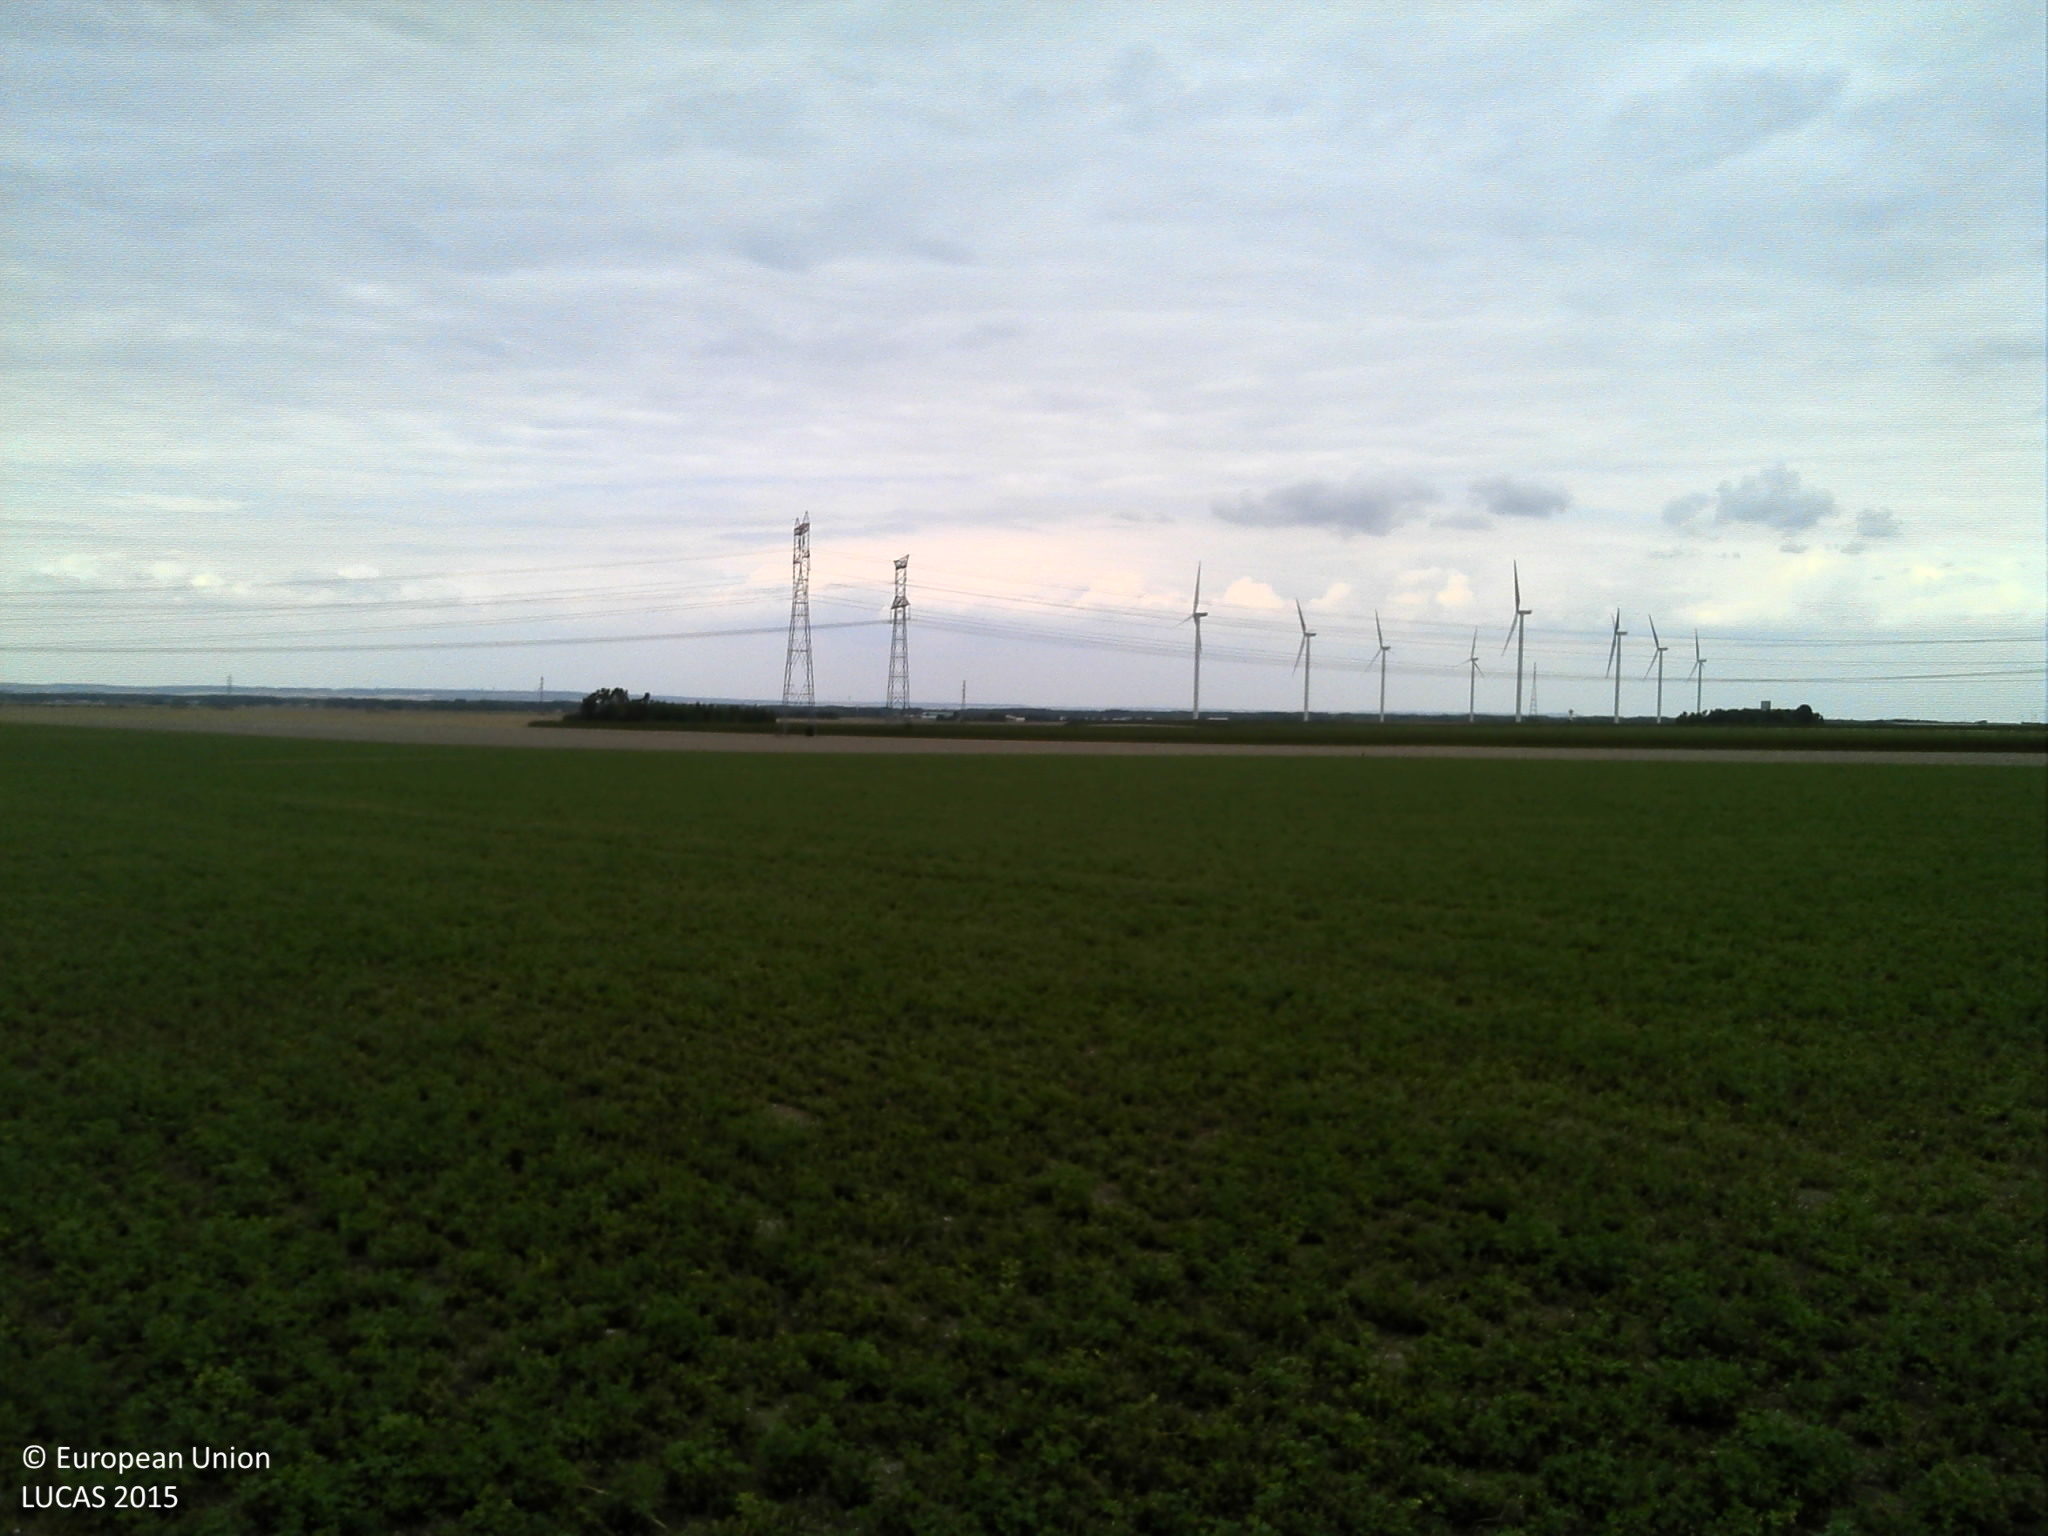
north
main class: Cropland
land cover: Lucerne
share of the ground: 50 - 75 %
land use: Agriculture (excluding fallow land and kitchen gardens)
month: August
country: FR
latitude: 48.4649
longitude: 3.8146
